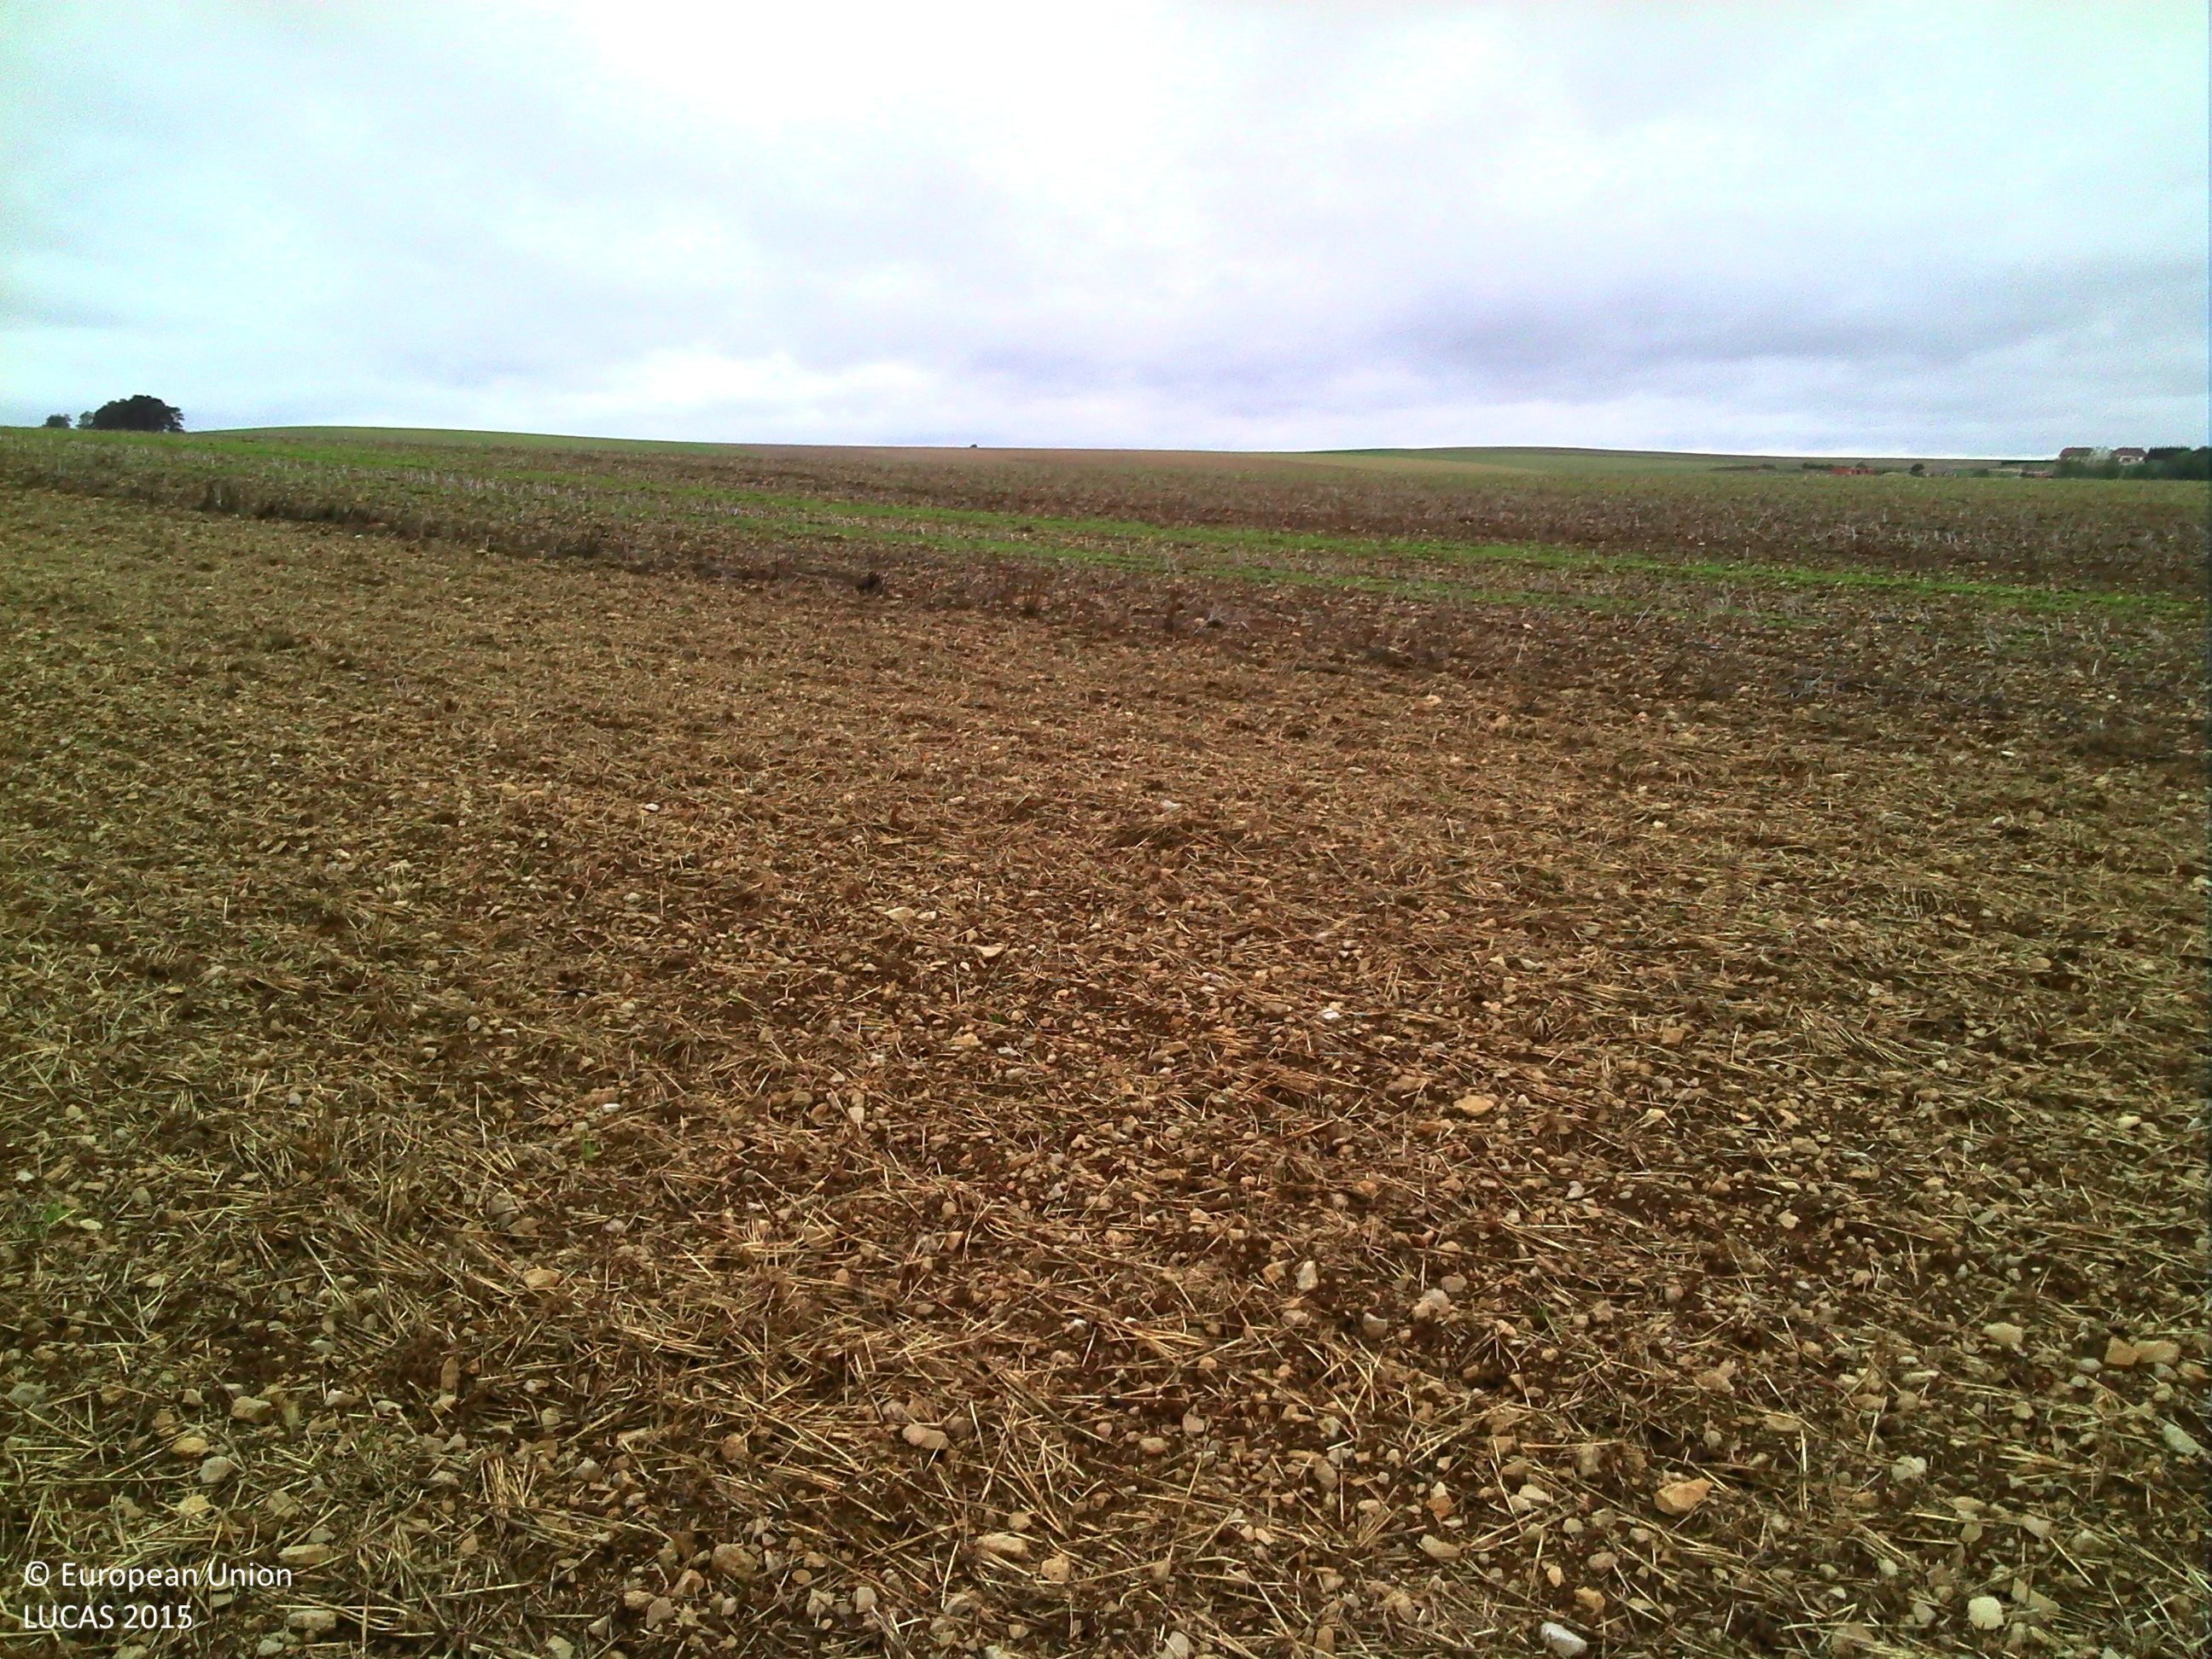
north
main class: Cropland
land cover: Rape and turnip rape
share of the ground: < 10 %
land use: Agriculture (excluding fallow land and kitchen gardens)
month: September
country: FR
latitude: 48.0740
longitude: 4.6161
